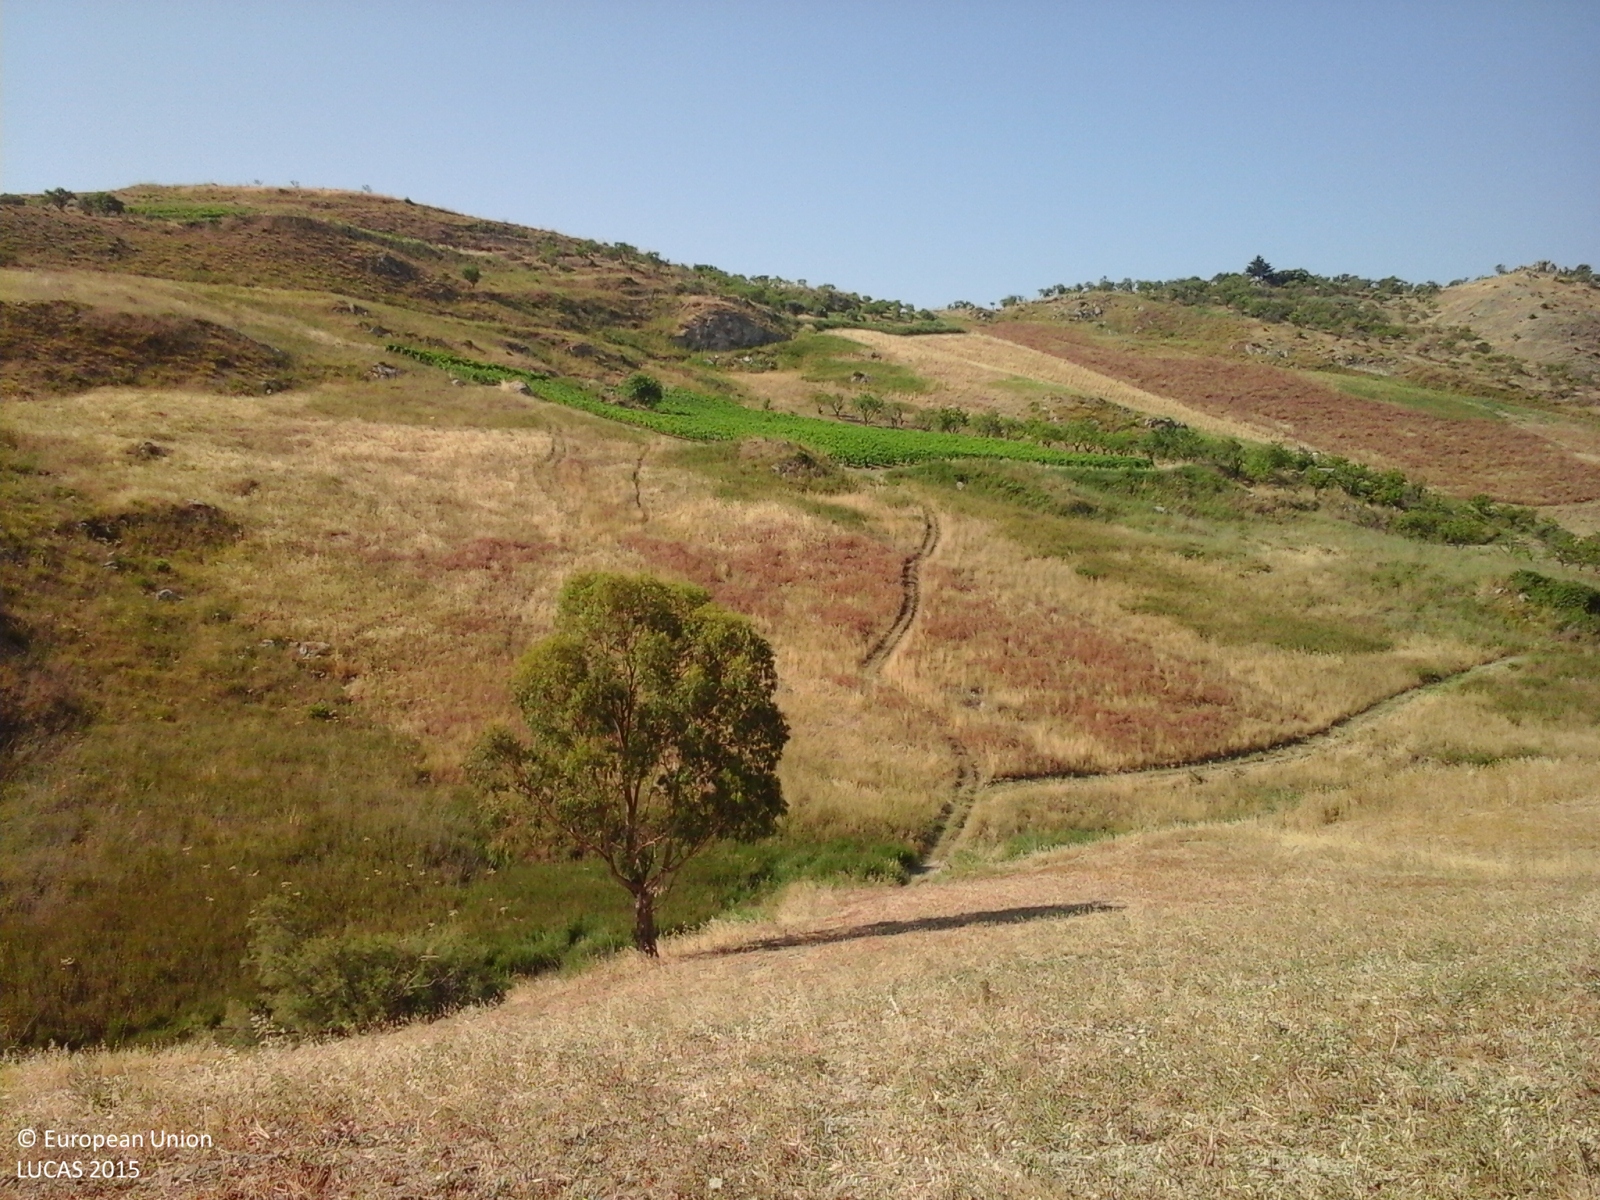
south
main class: Cropland
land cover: Lucerne
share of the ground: > 75 %
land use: Agriculture (excluding fallow land and kitchen gardens)
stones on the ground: < 10 %
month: July
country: IT
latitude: 37.4110
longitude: 13.4868
